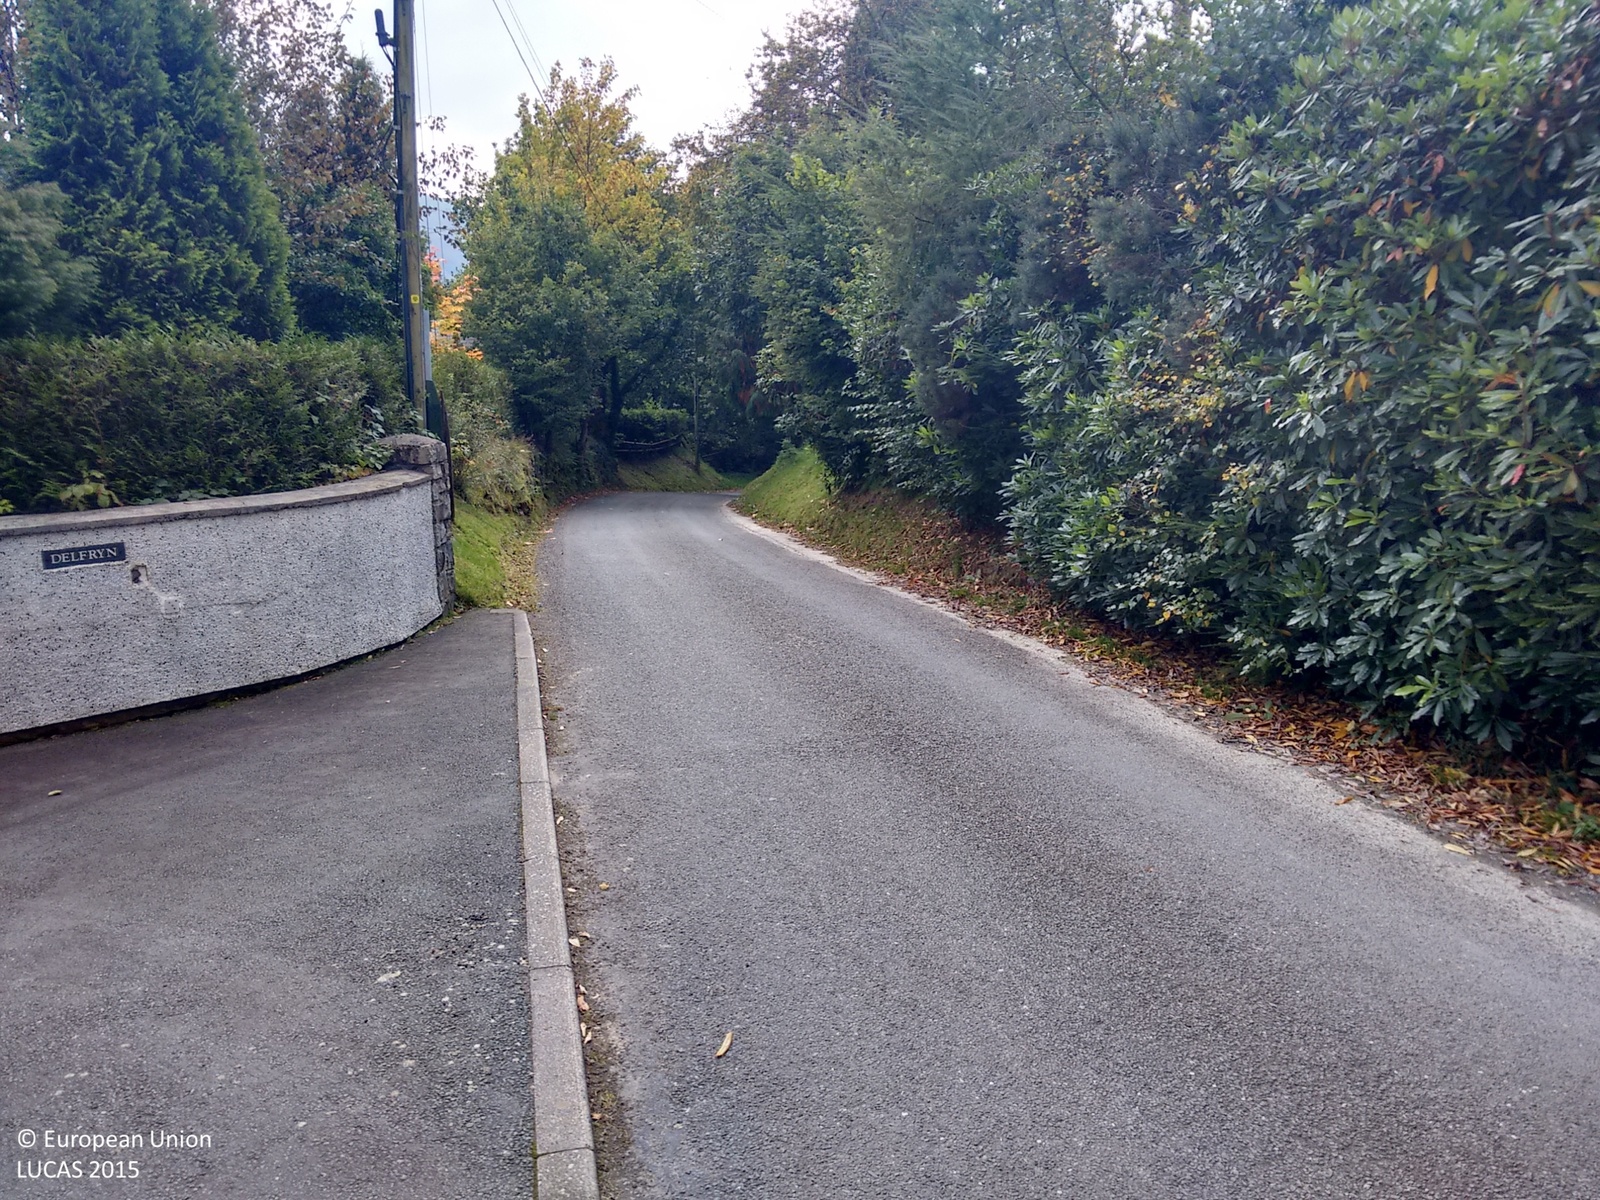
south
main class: Grassland
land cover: Grassland without tree/shrub cover
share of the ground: > 75 %
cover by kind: herbaceous plants 100 %
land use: Residential
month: September
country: GB
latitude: 52.7106
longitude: -3.6908
